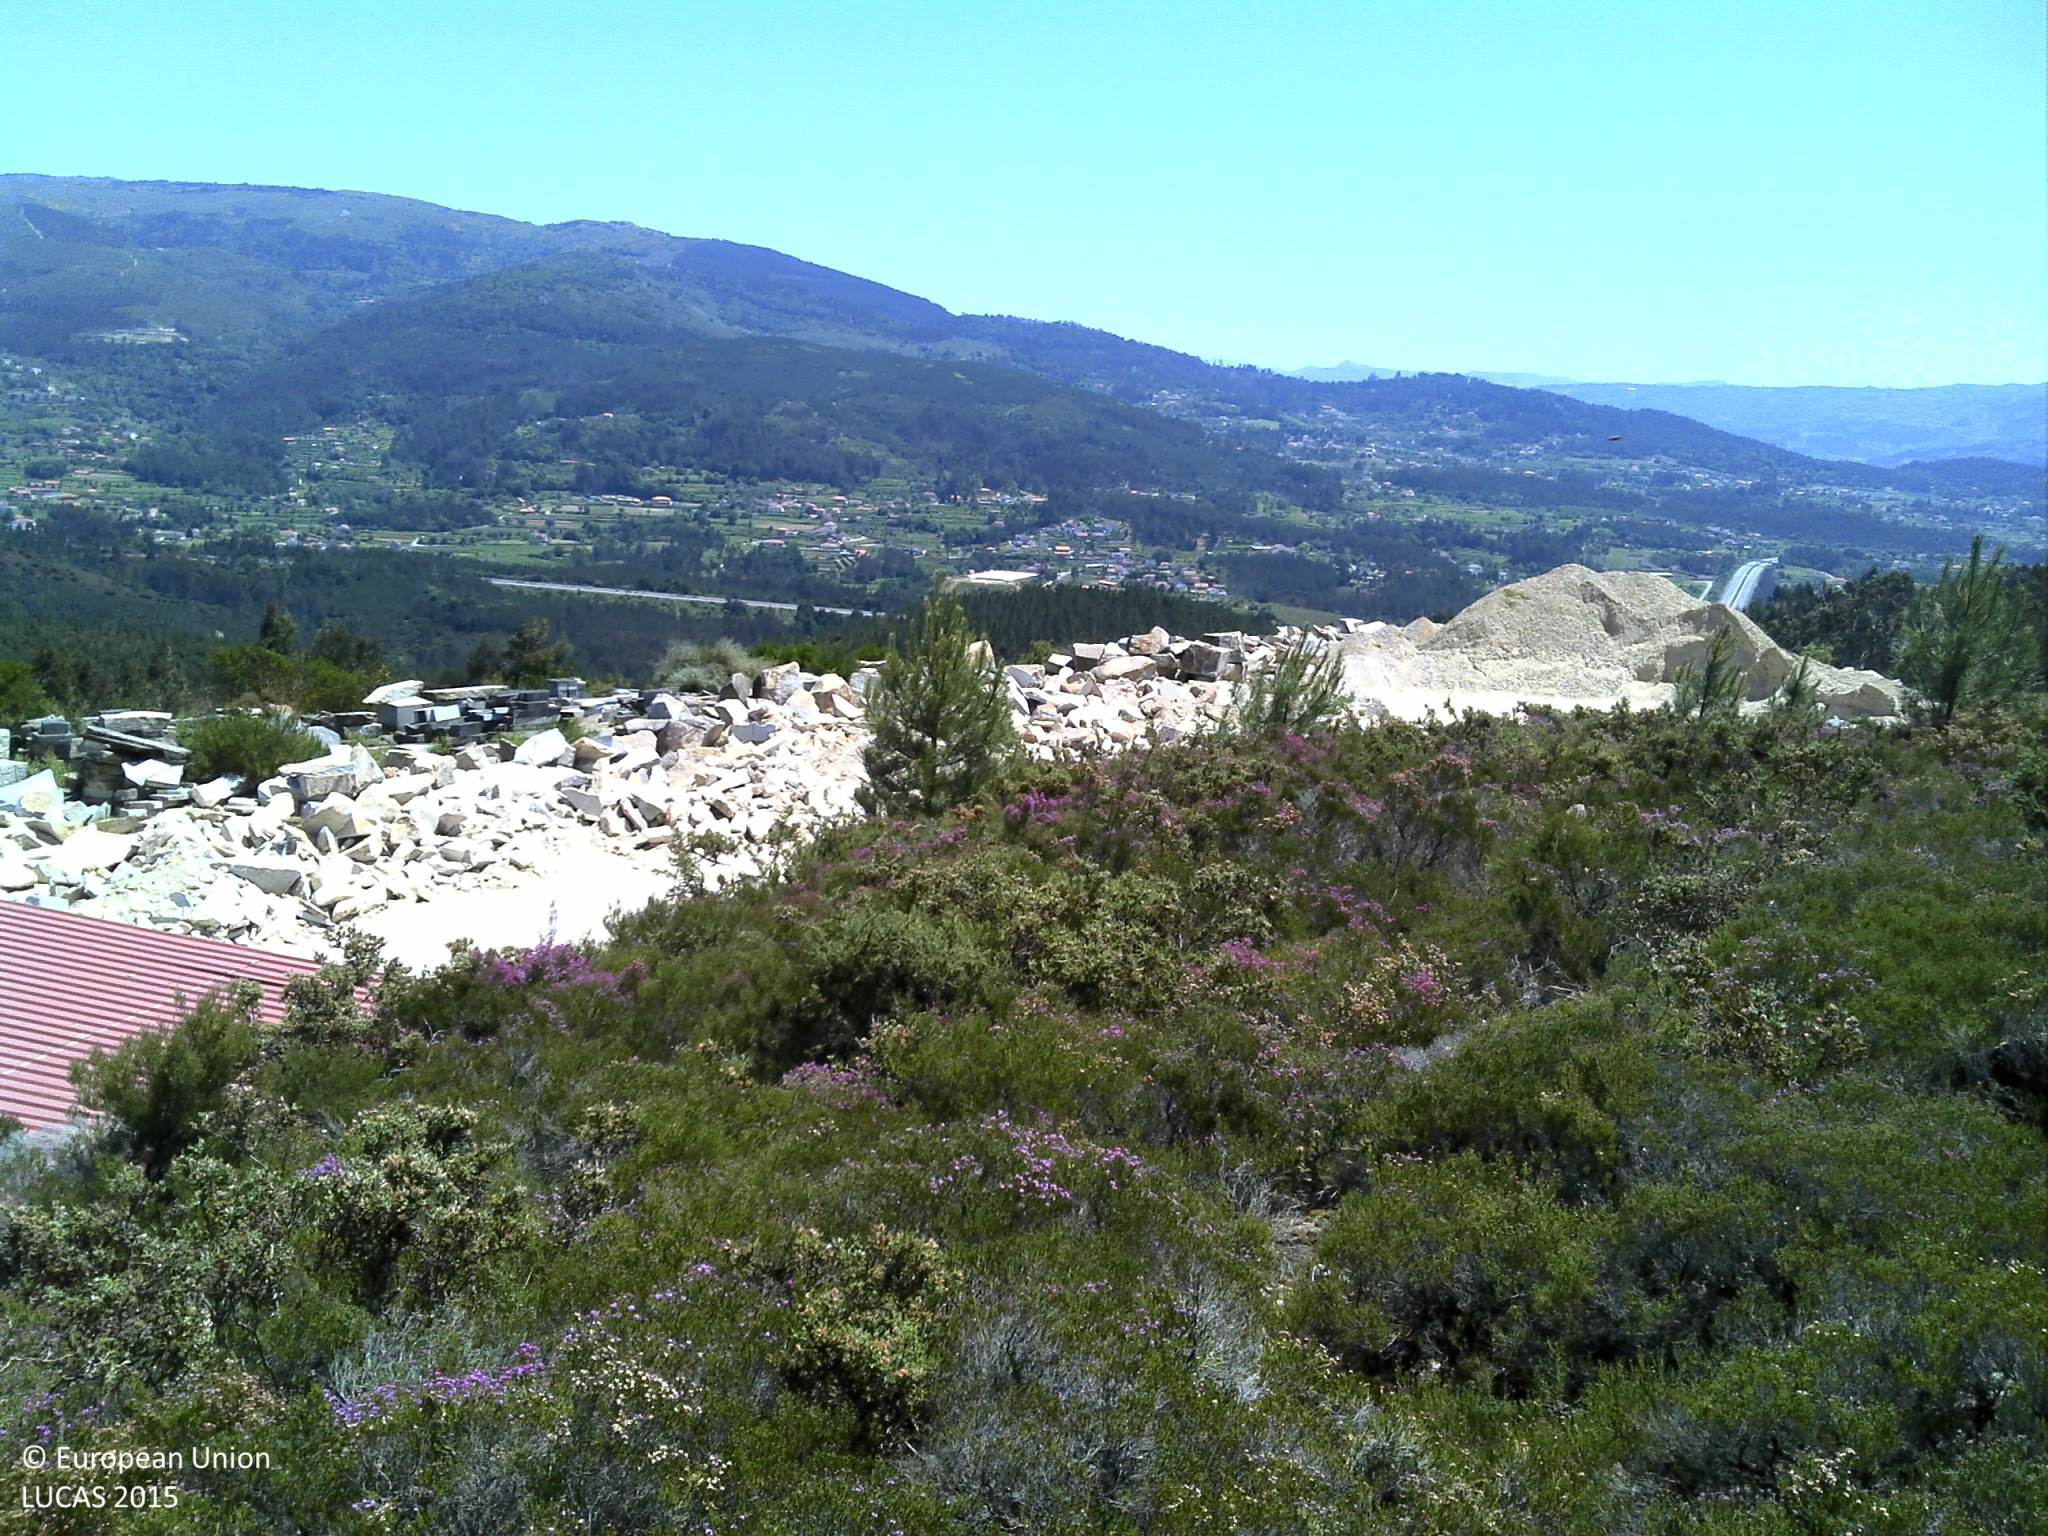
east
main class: Shrubland
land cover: Shrubland without tree cover
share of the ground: 50 - 75 %
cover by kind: shrubs 75 %, unconsolidated bare surface 20 %, herbaceous plants 5 %
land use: Semi-natural and natural areas not in use
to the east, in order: Shrubland without tree cover; Artificial constructions in urban areas; Shrubland without tree cover; Shrubland with sparse tree cover; Tracks; Shrubland with sparse tree cover; Other bare soil; Grass margins; Paved roads, cycling and walking lanes; Grass margins; Shrubland with sparse tree cover
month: May
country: PT
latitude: 41.8154
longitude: -8.6184
